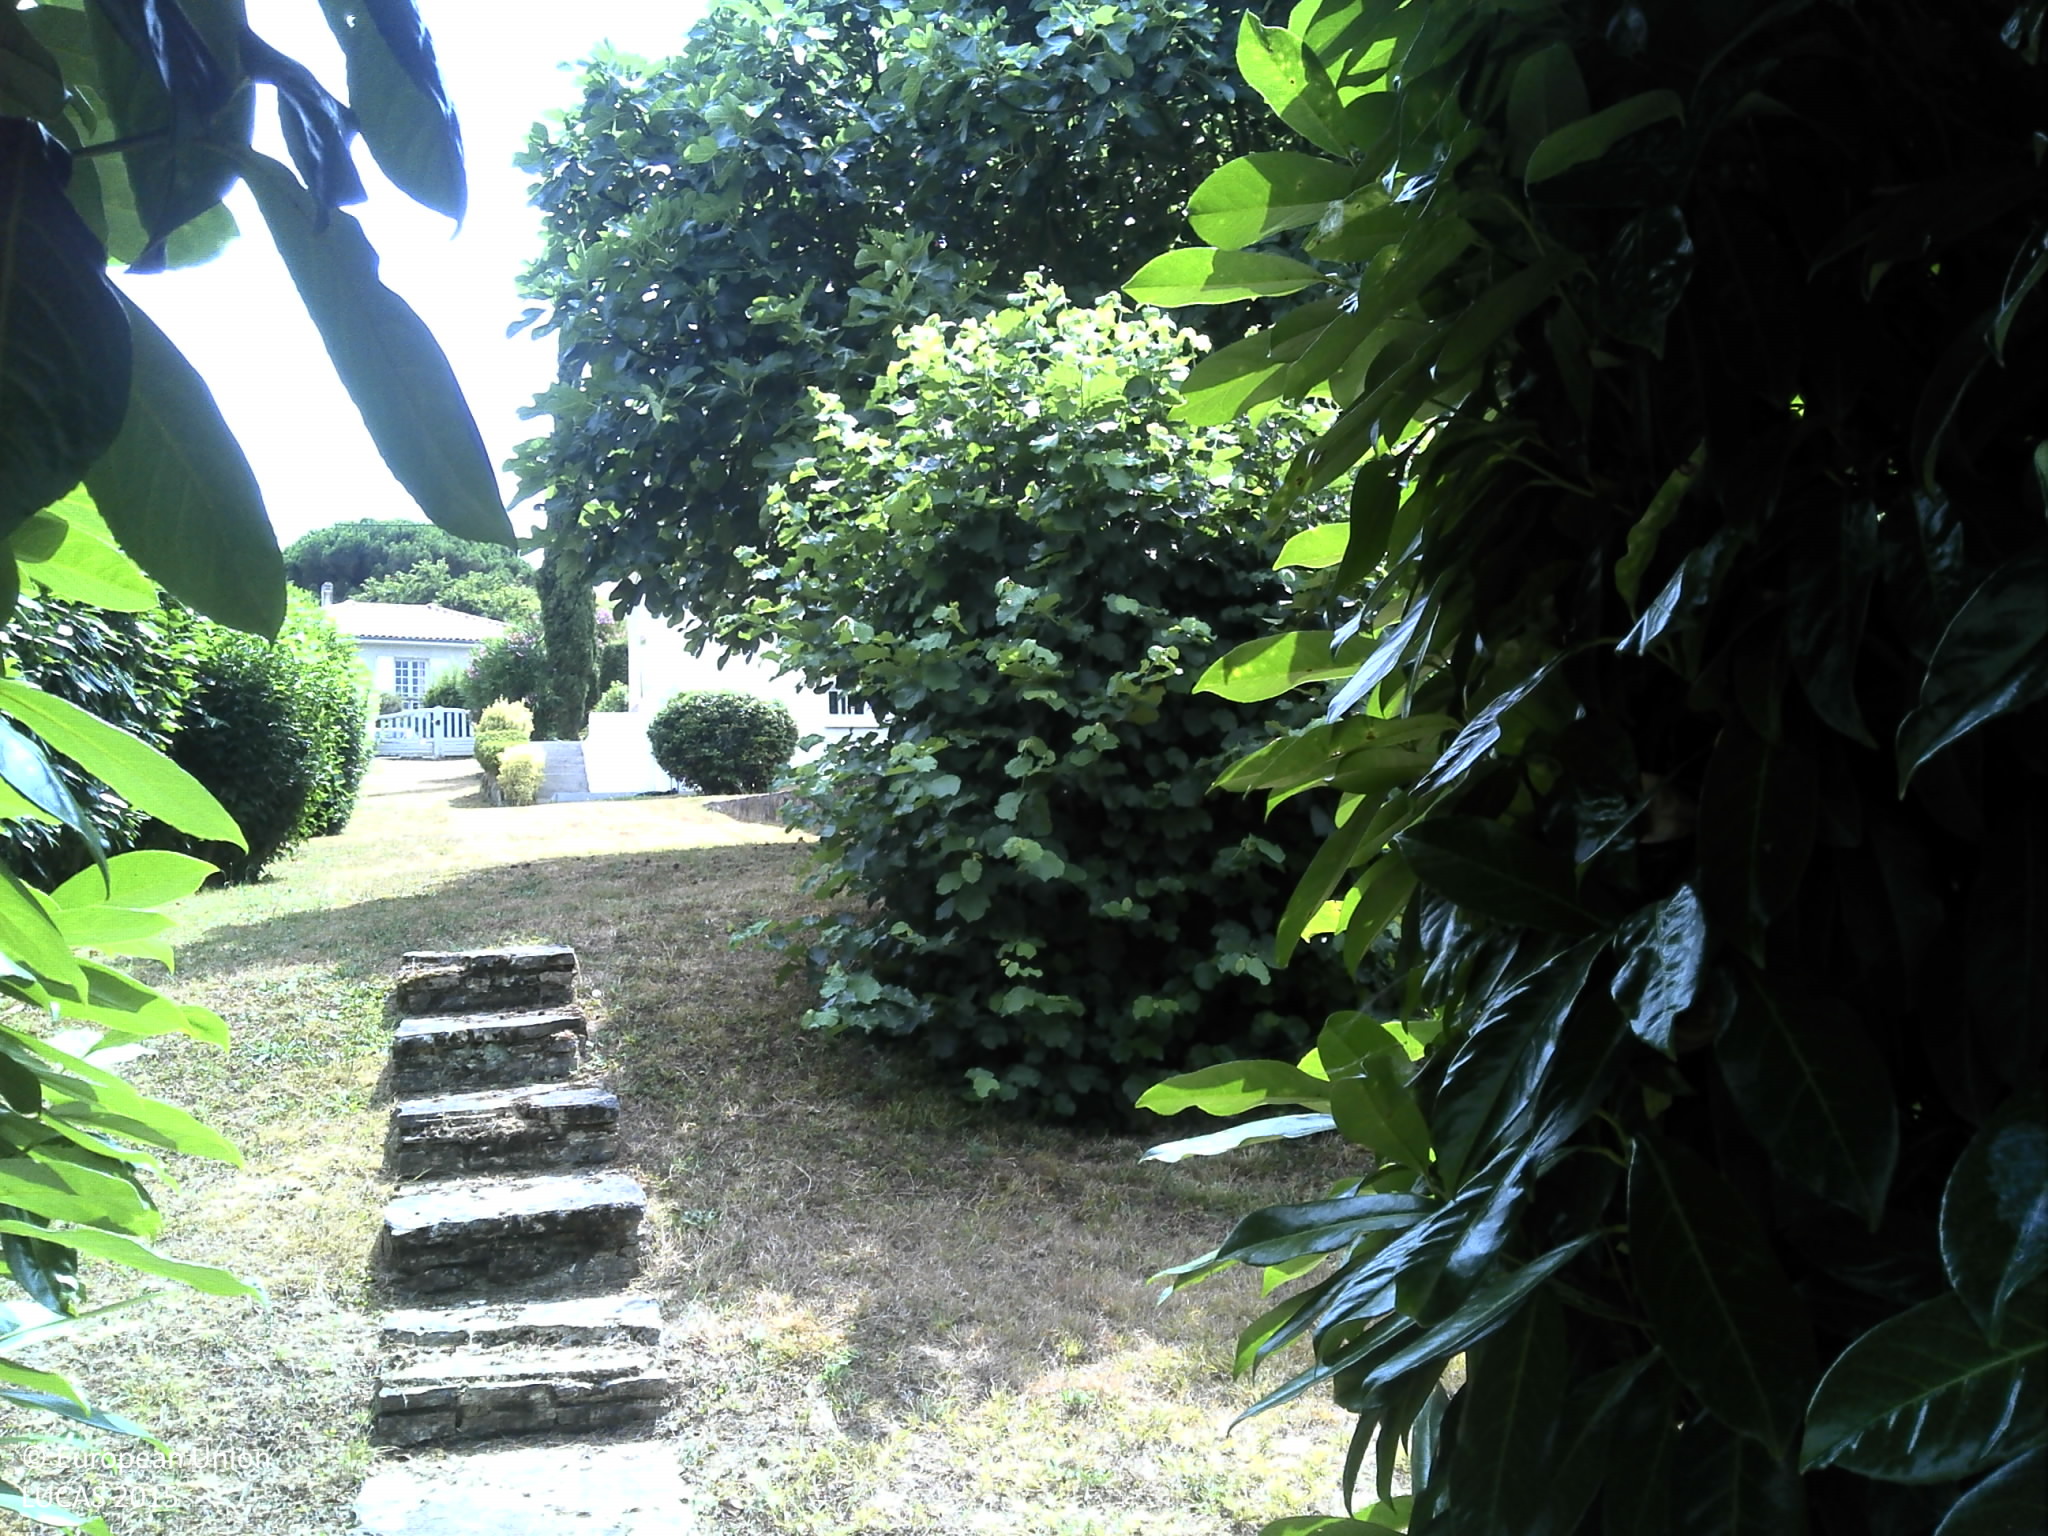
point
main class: Grassland
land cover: Grassland with sparse tree/shrub cover
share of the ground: > 75 %
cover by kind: herbaceous plants 85 %, unconsolidated bare surface 10 %, broadleaved forest trees 5 %
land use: Residential
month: July
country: FR
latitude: 44.8158
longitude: -0.5007
